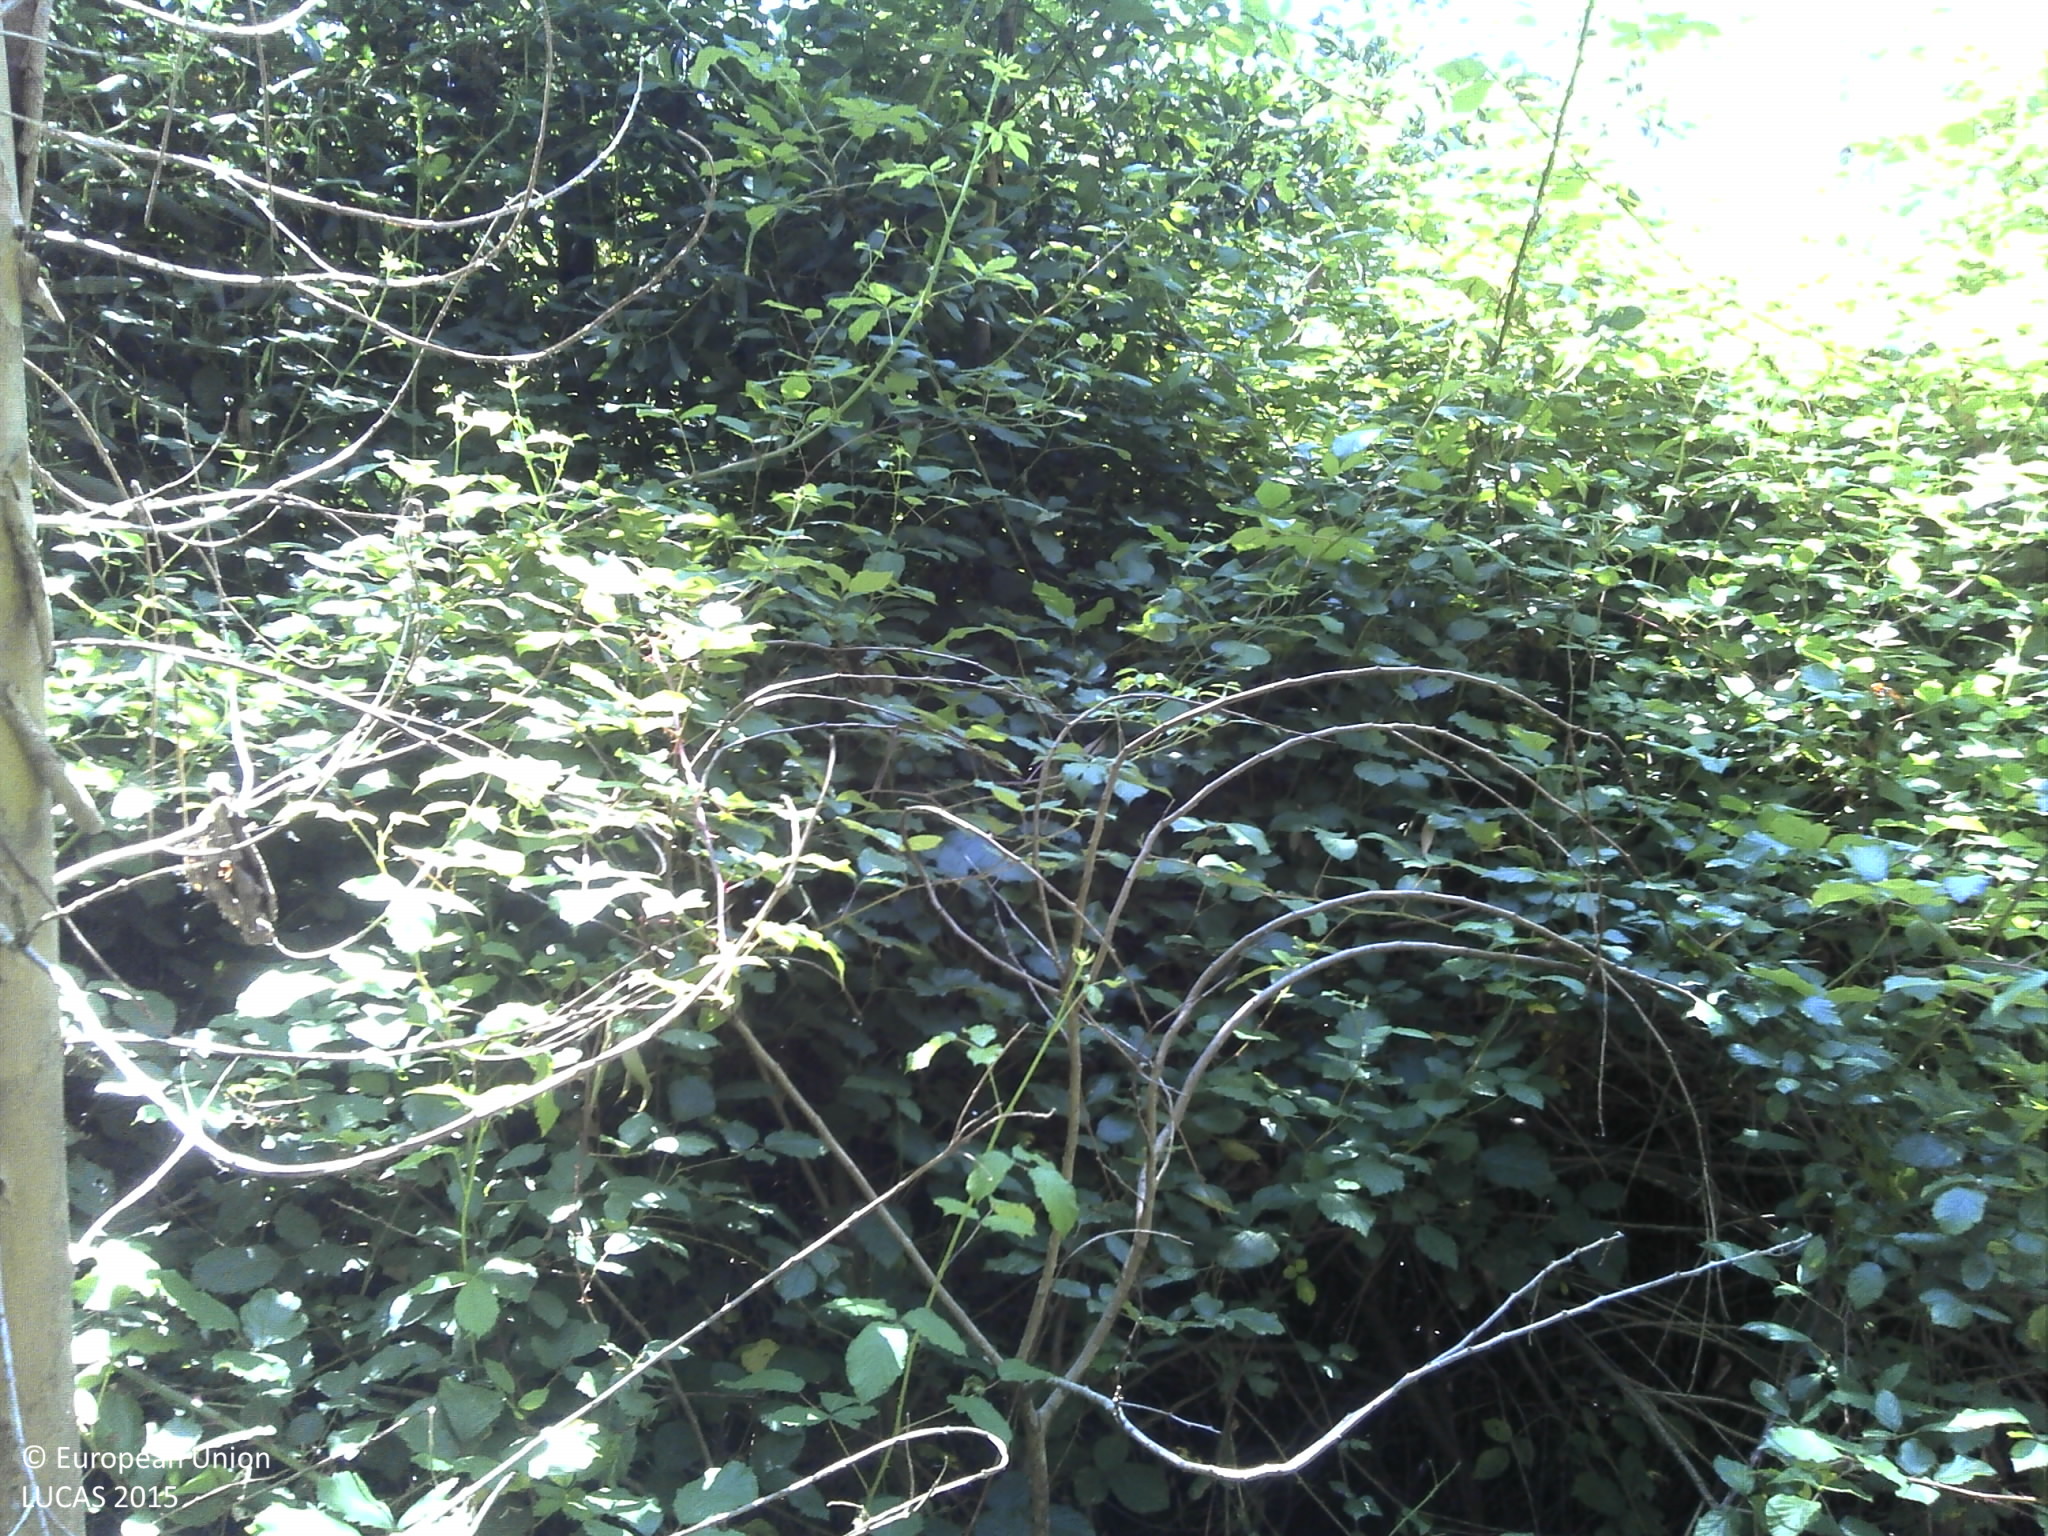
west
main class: Shrubland
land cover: Shrubland with sparse tree cover
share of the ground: > 75 %
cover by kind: shrubs 80 %, unconsolidated bare surface 15 %, broadleaved forest trees 5 %
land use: Semi-natural and natural areas not in use
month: May
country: PT
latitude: 40.4474
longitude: -8.7133
